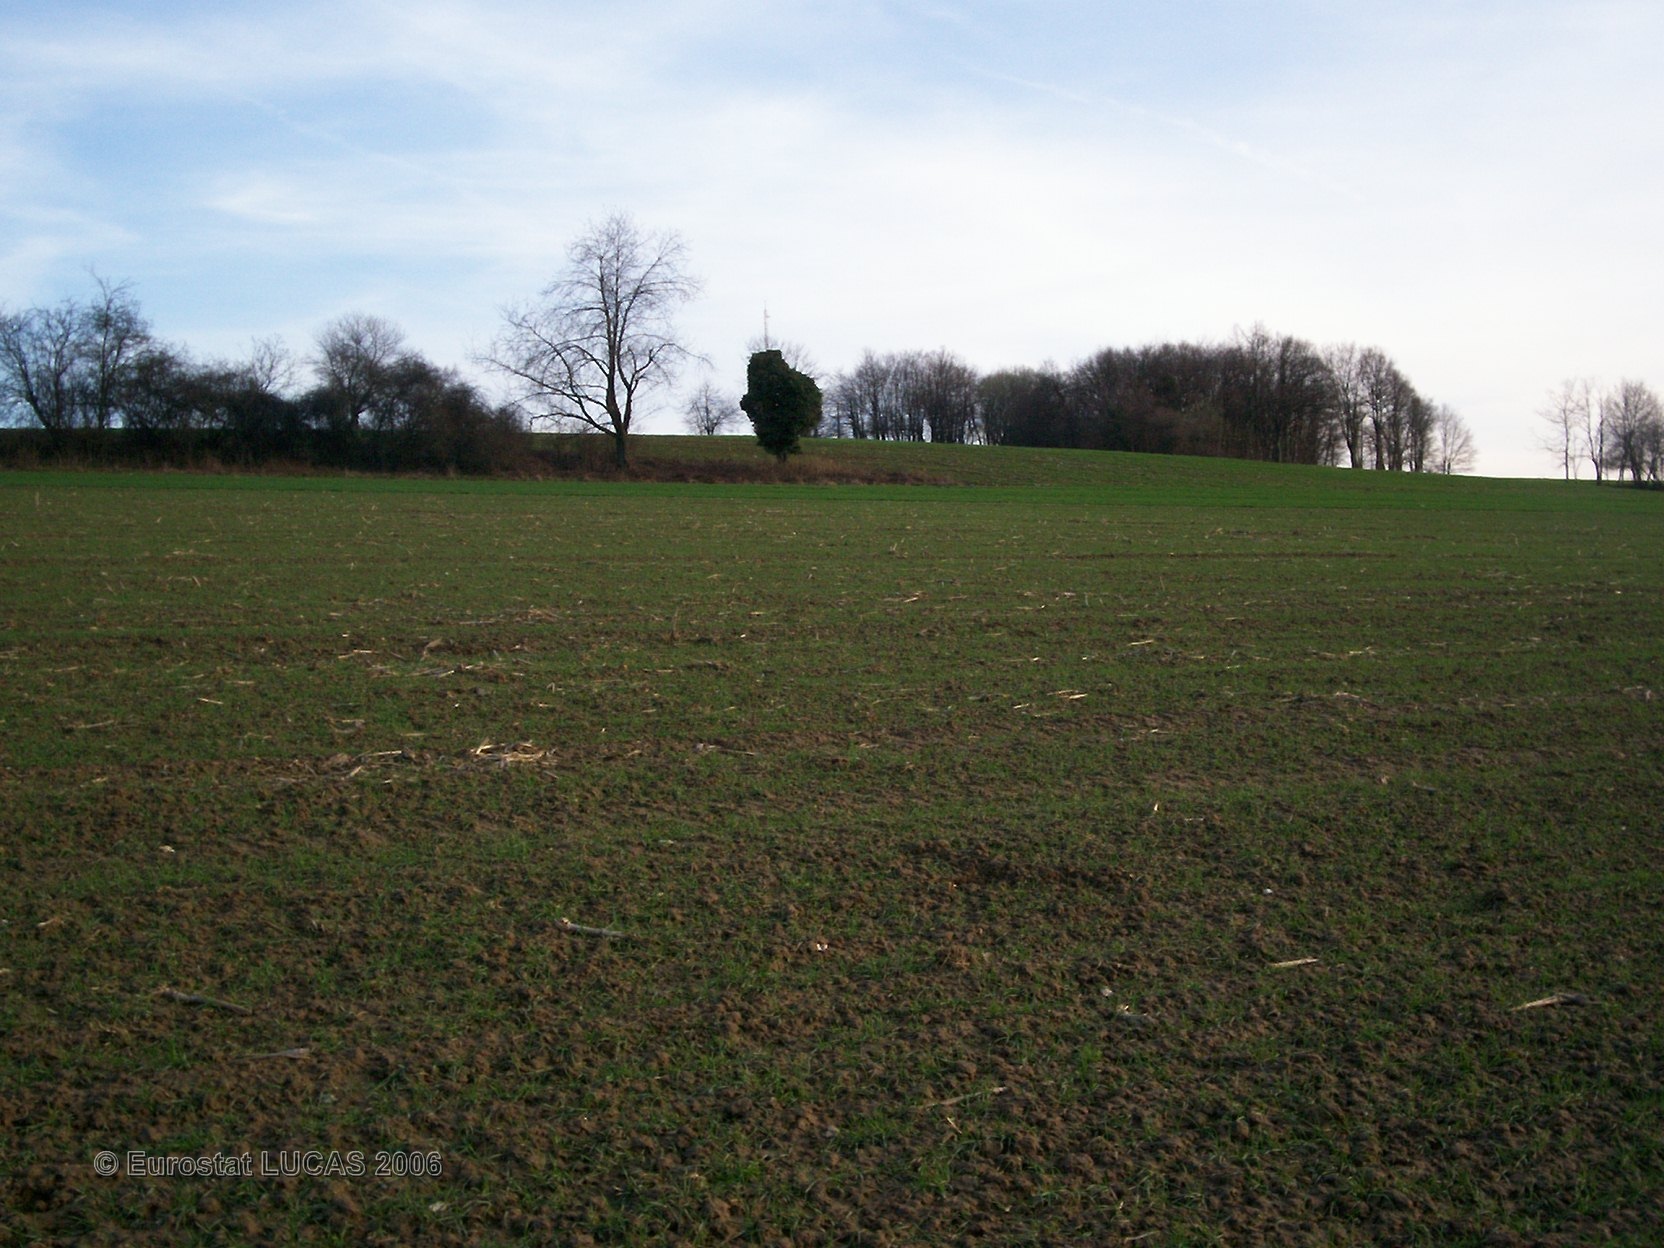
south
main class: Cropland
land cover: Common wheat
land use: Agriculture (excluding fallow land and kitchen gardens)
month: April
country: FR
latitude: 47.4621
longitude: 6.9905
